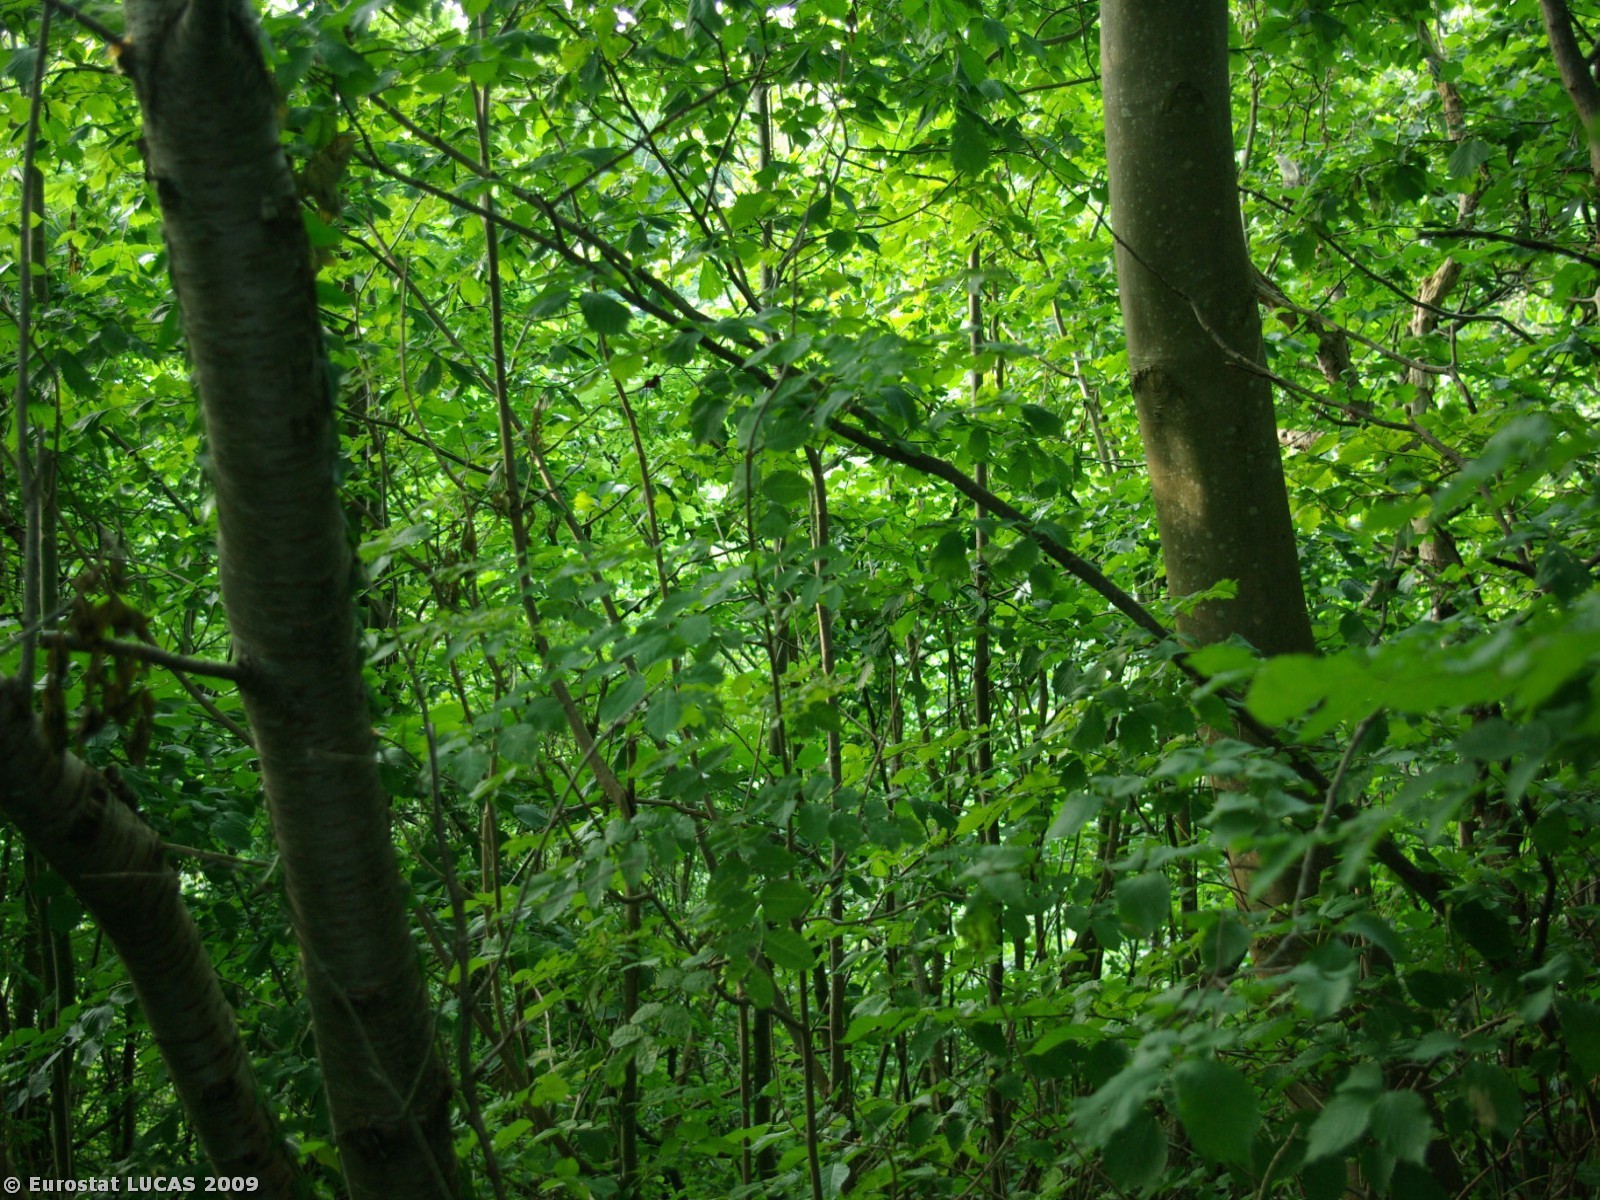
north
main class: Woodland
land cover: Broadleaved woodland
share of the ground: > 75 %
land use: Unused
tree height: > 5 m
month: July
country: DK
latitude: 54.9475
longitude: 9.8908
